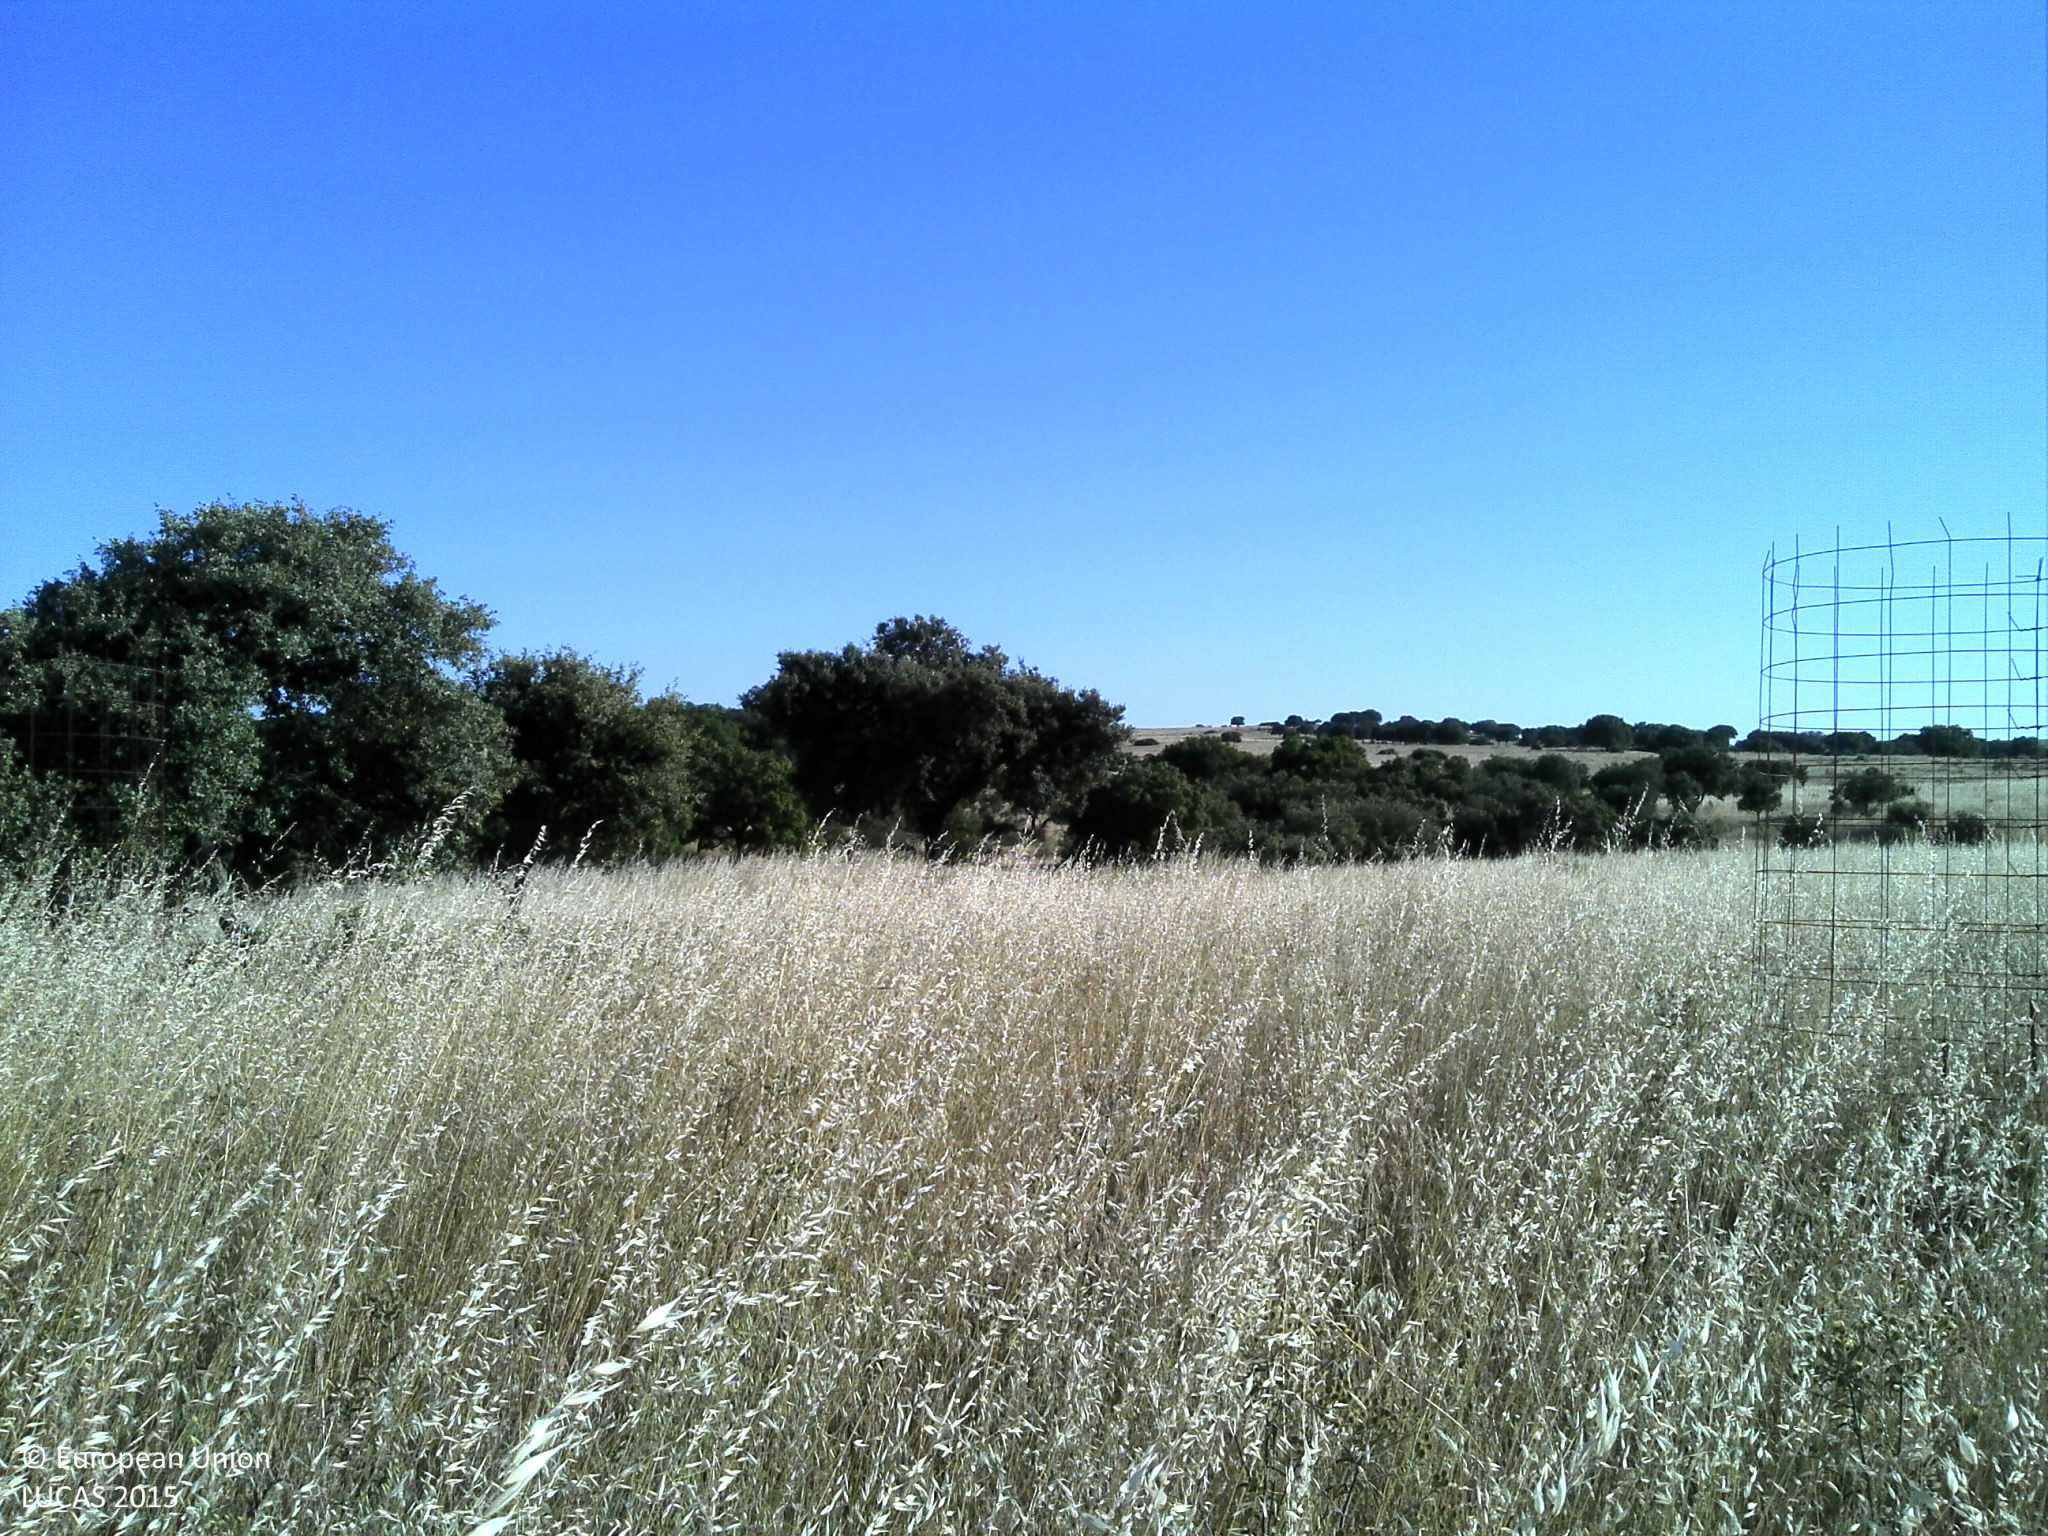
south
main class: Grassland
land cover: Grassland with sparse tree/shrub cover
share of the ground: > 75 %
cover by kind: herbaceous plants 90 %, broadleaved forest trees 5 %, unconsolidated bare surface 5 %
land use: Agriculture (excluding fallow land and kitchen gardens)
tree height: < 5 m
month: May
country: PT
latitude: 39.2312
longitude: -7.6185
